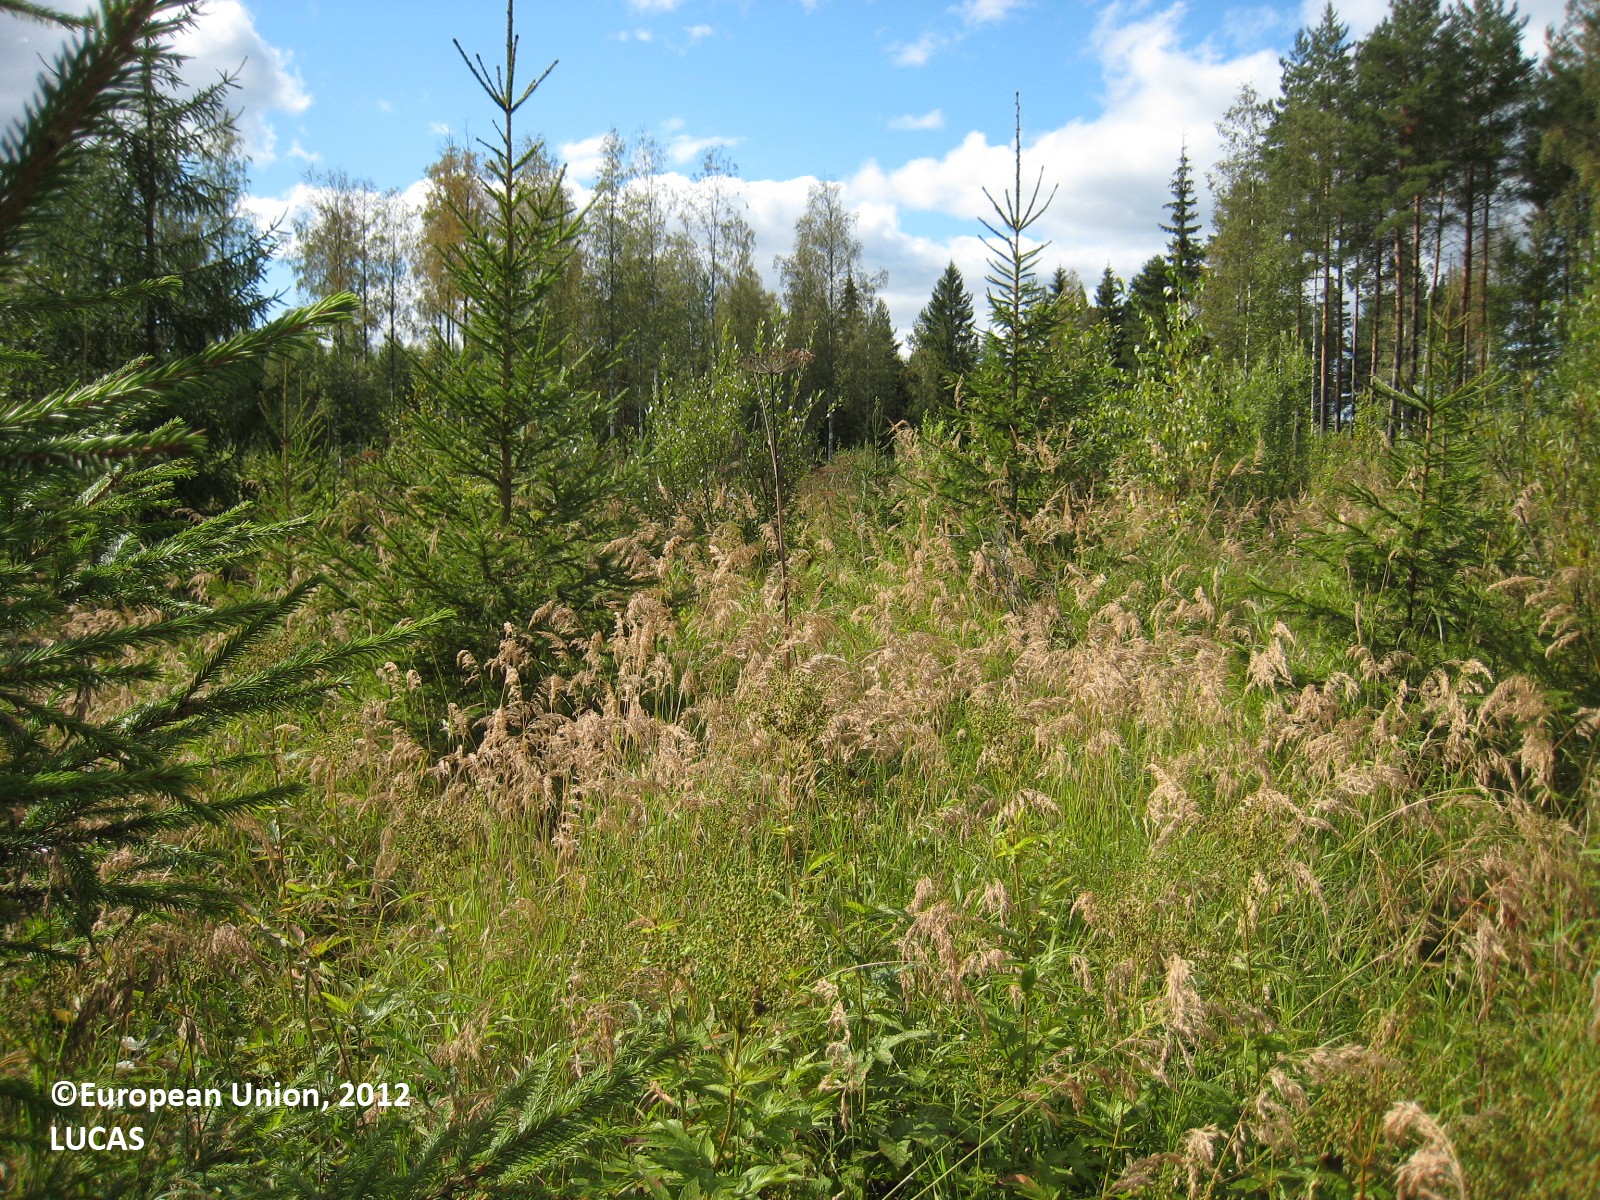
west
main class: Woodland
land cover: Spruce dominated mixed woodland
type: boreal forest
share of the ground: 50 - 75 %
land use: Forestry
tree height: < 5 m
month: August
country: FI
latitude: 61.9807
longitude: 27.2035
